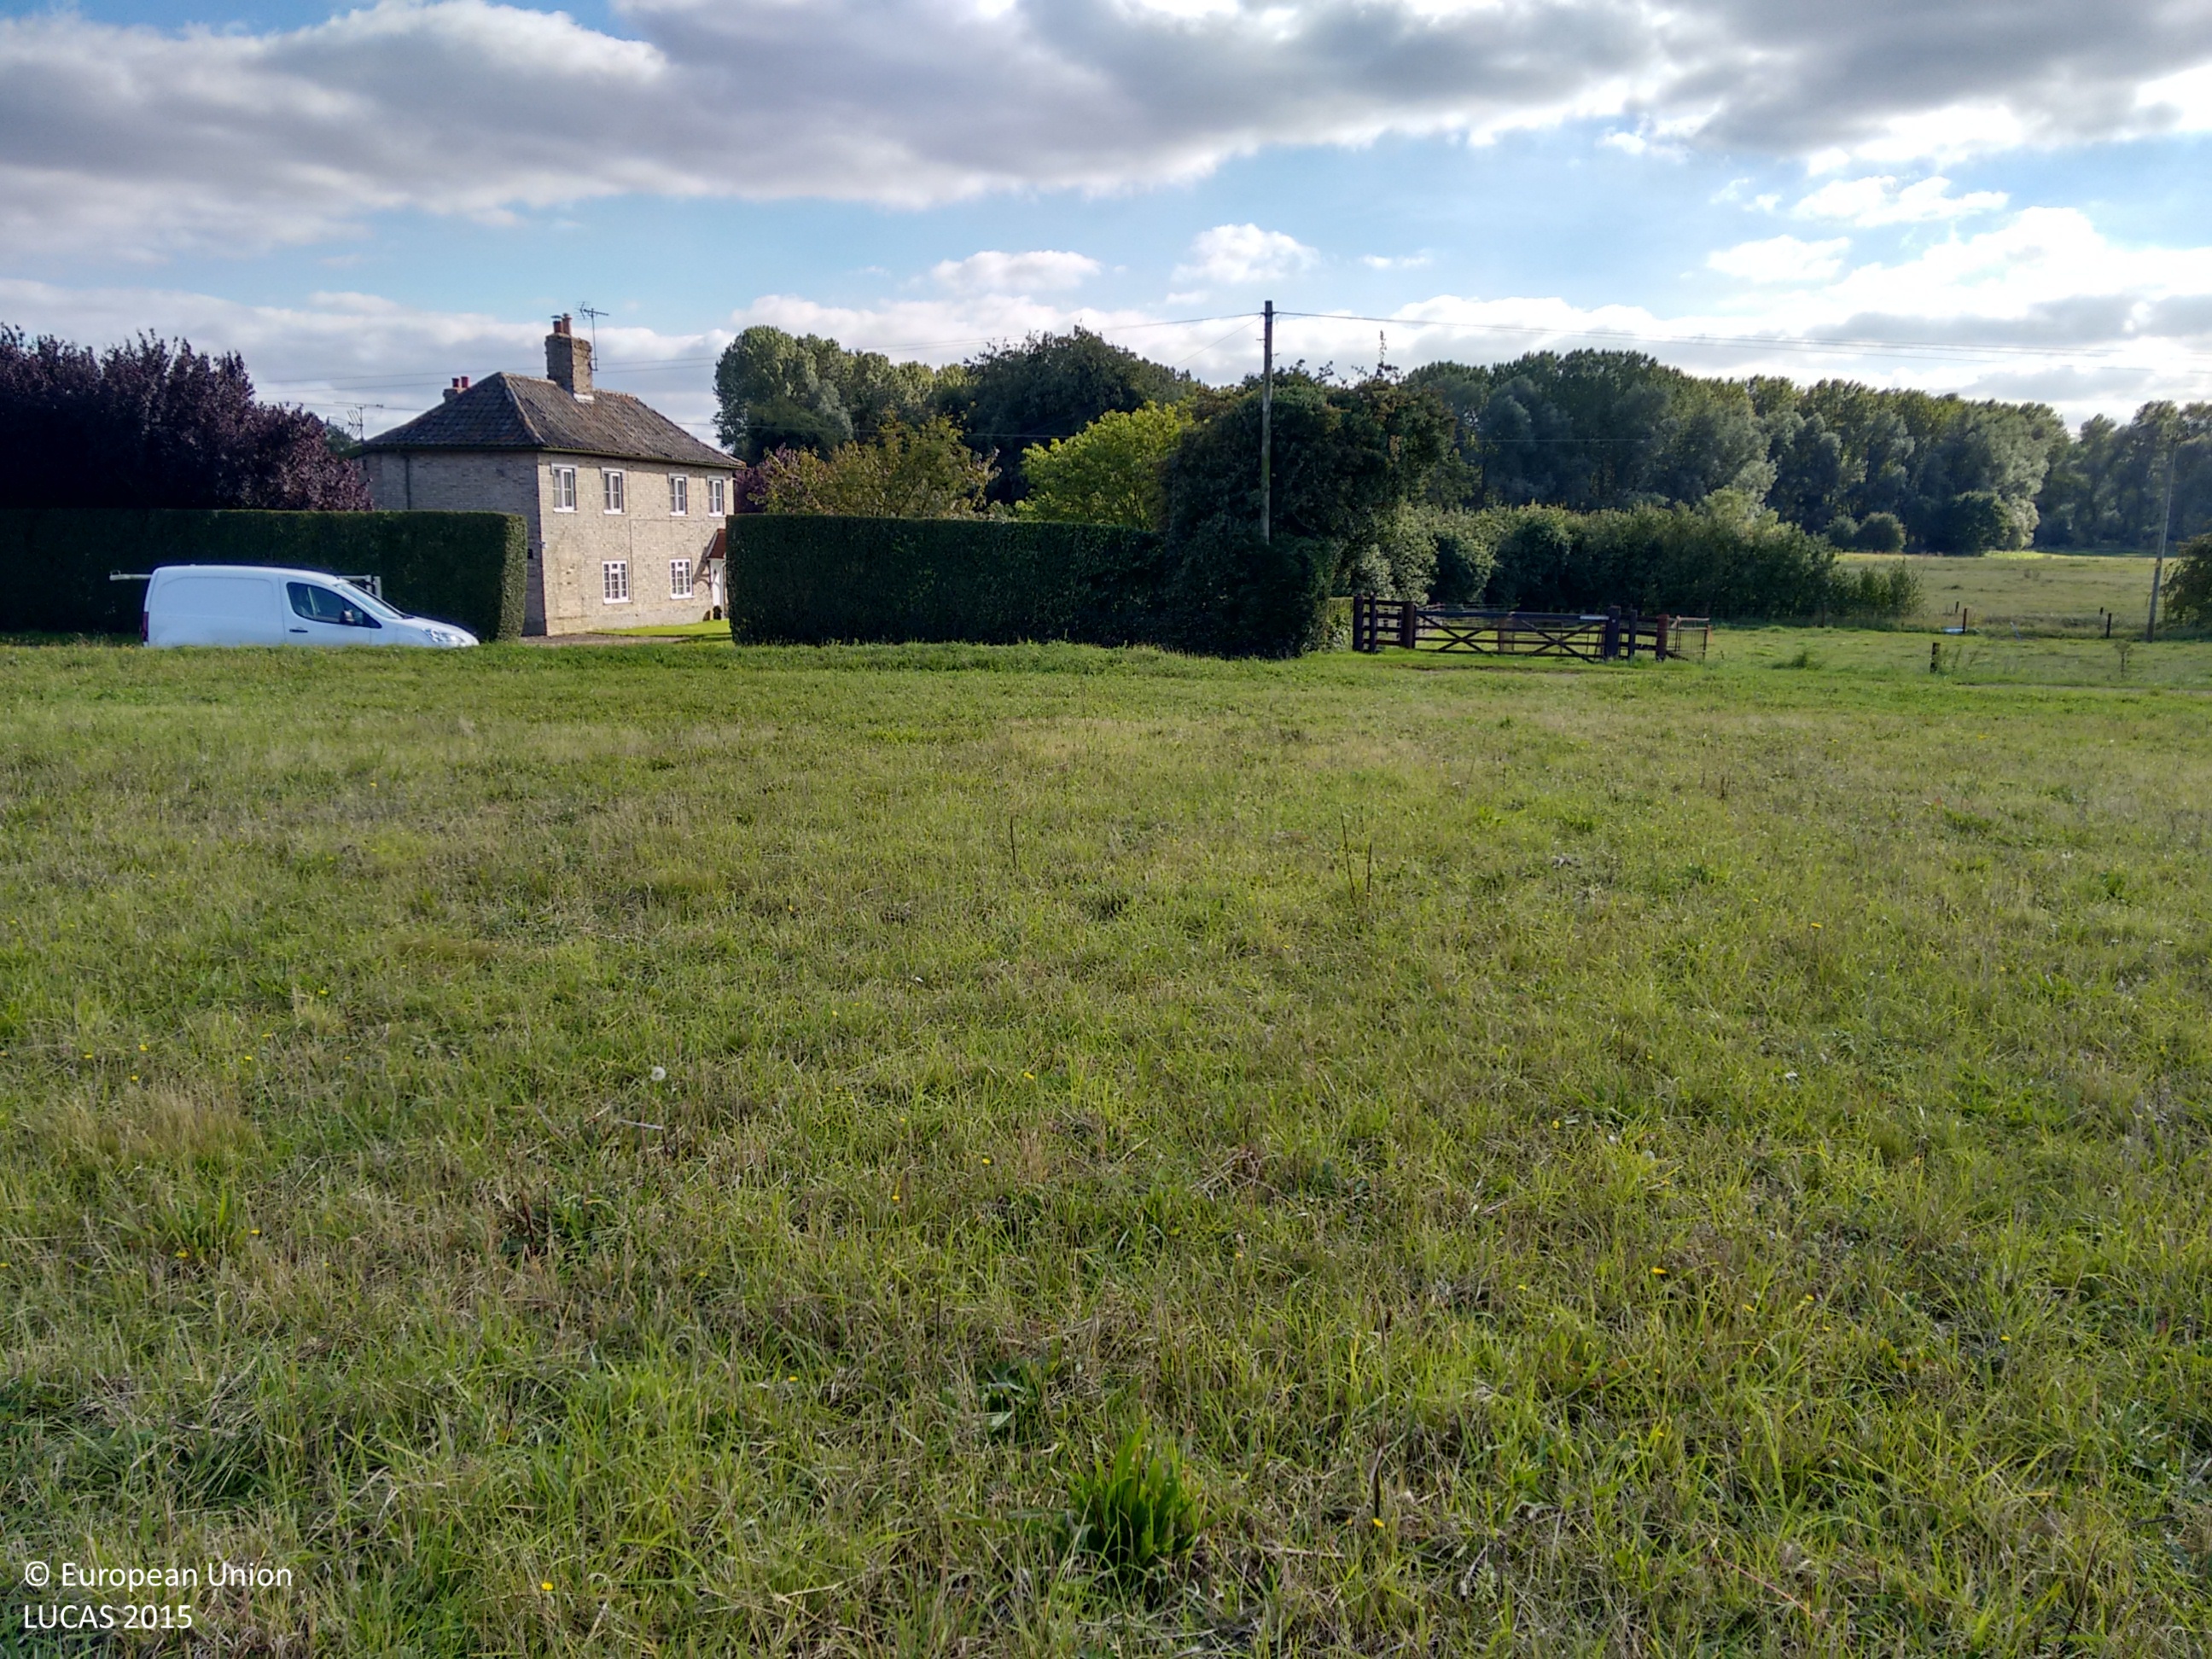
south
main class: Grassland
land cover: Grassland without tree/shrub cover
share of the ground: > 75 %
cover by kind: herbaceous plants 100 %
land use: Agriculture (excluding fallow land and kitchen gardens)
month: September
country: GB
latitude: 52.3900
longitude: 0.9099
